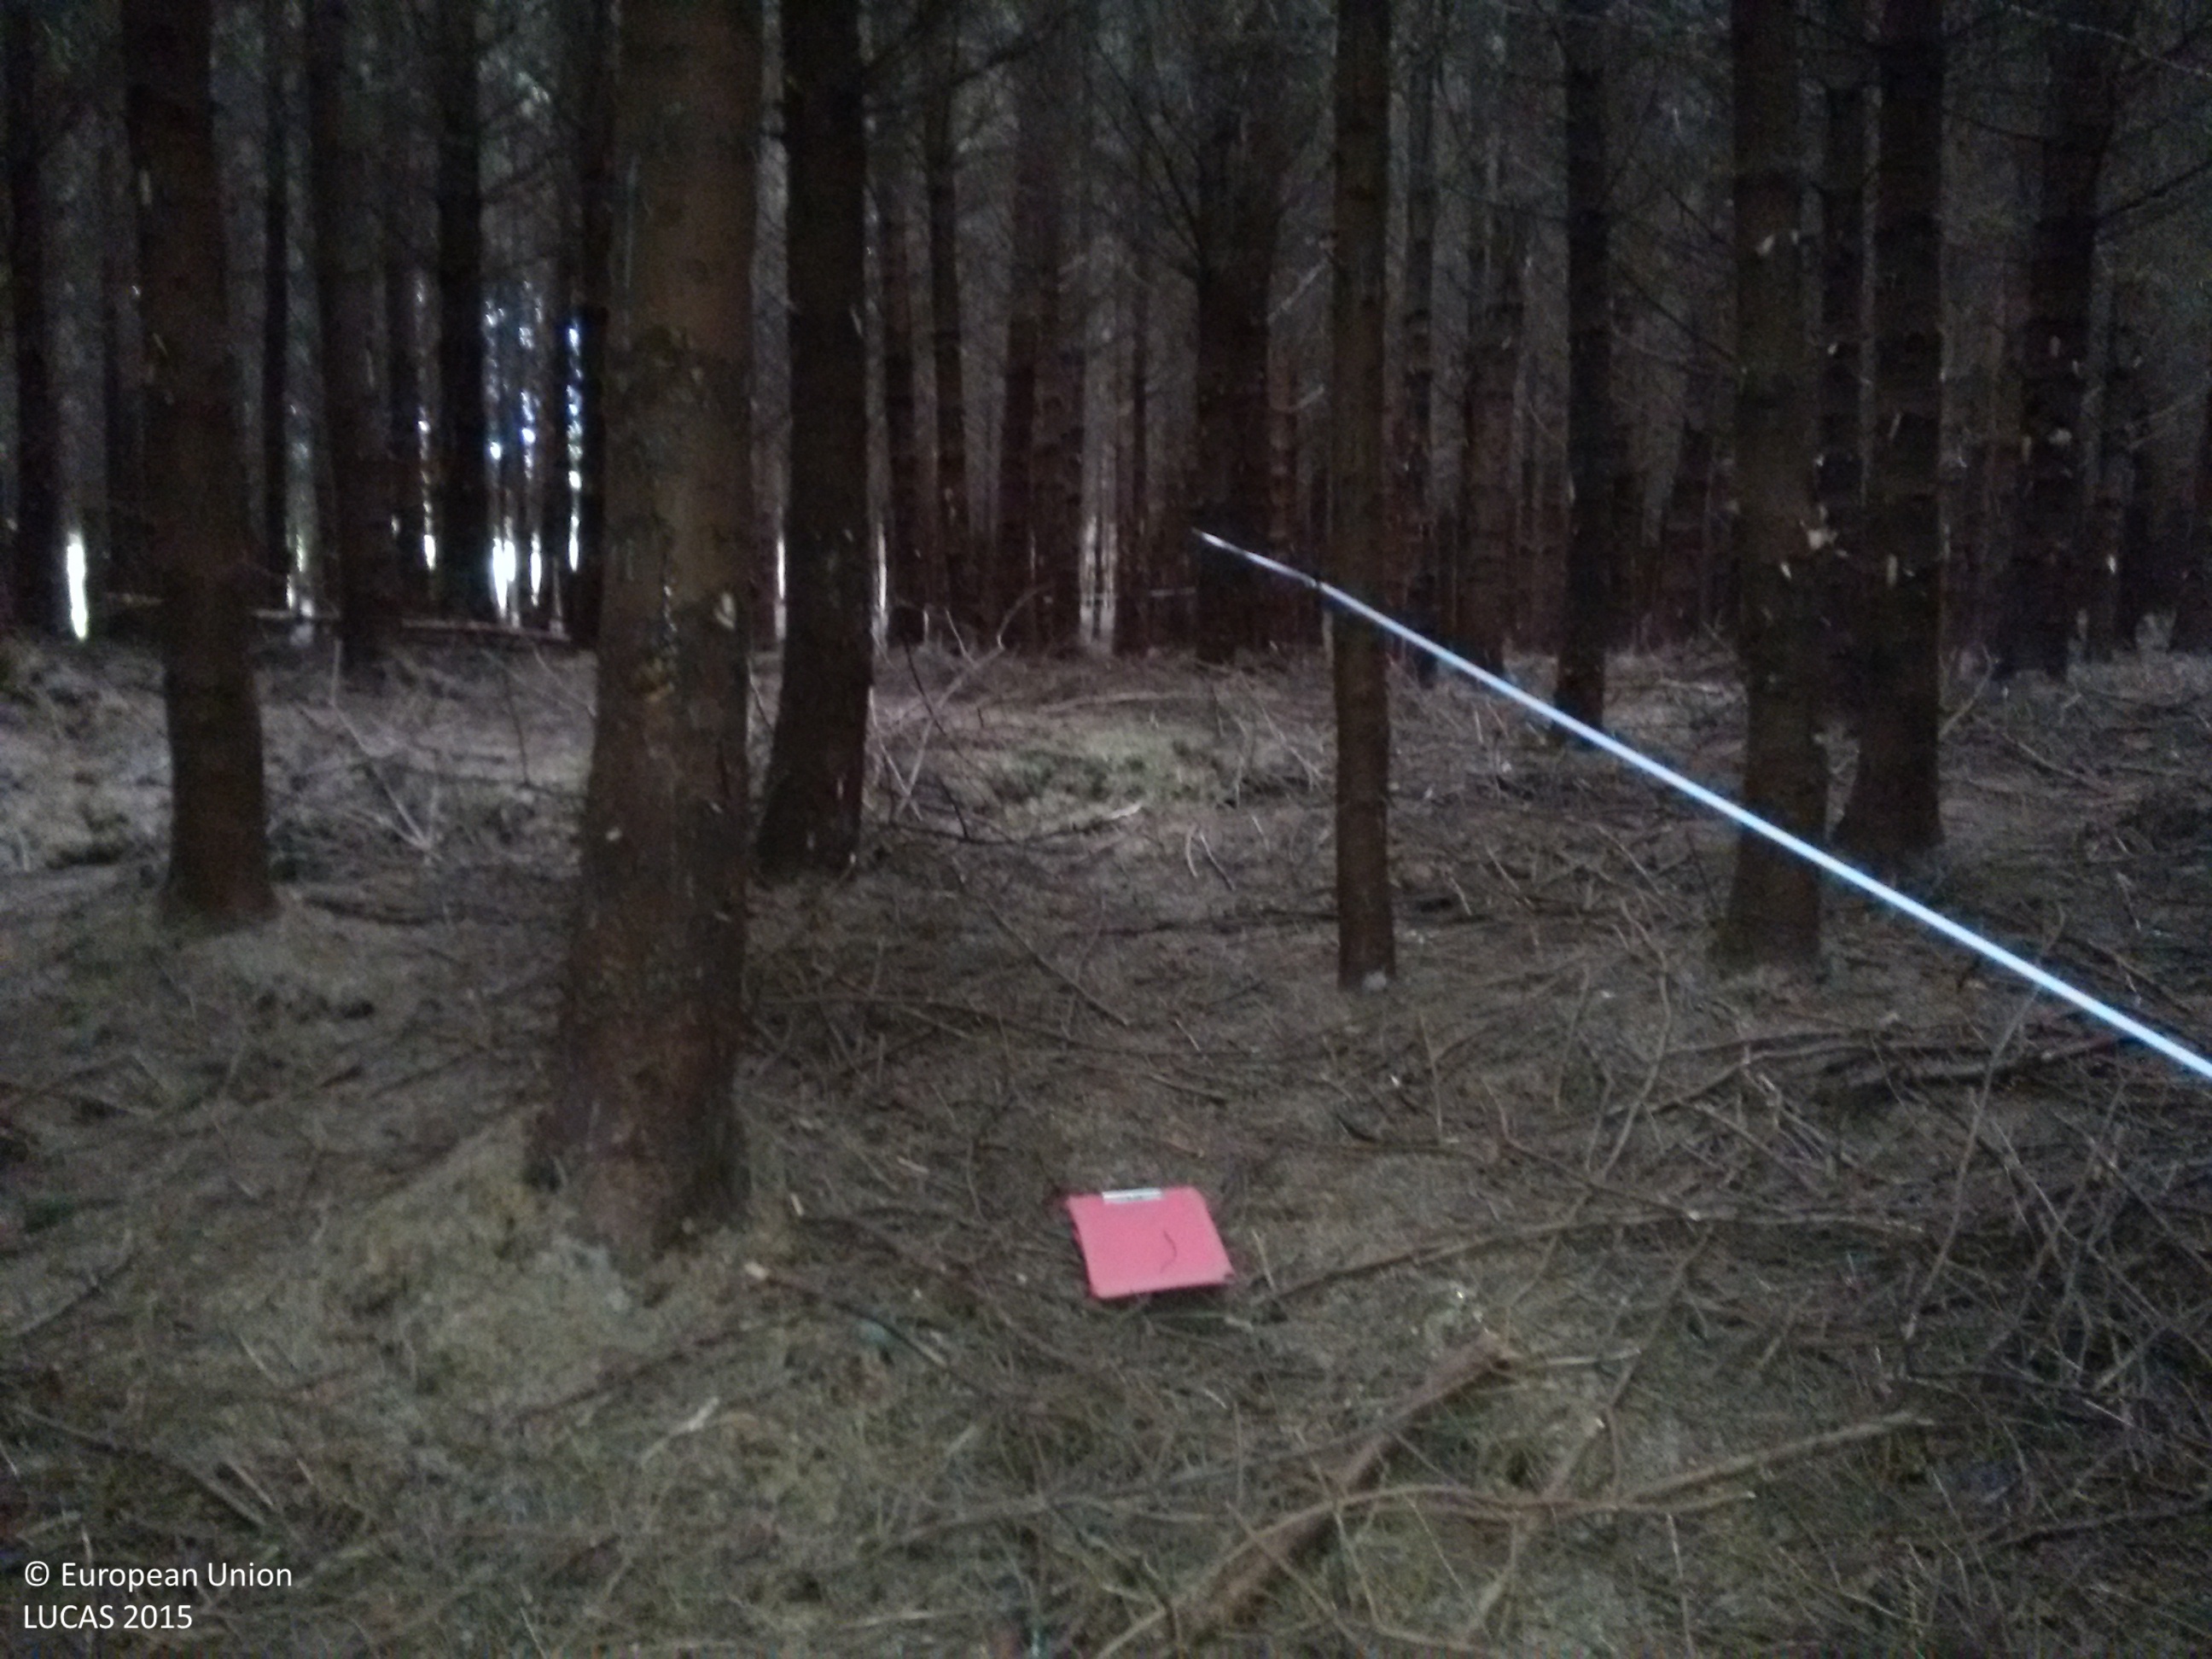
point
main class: Woodland
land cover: Spruce dominated coniferous woodland
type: exotic forest
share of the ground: > 75 %
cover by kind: coniferous forest trees 100 %
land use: Forestry
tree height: > 5 m
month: September
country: IE
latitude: 52.9969
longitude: -9.2805
